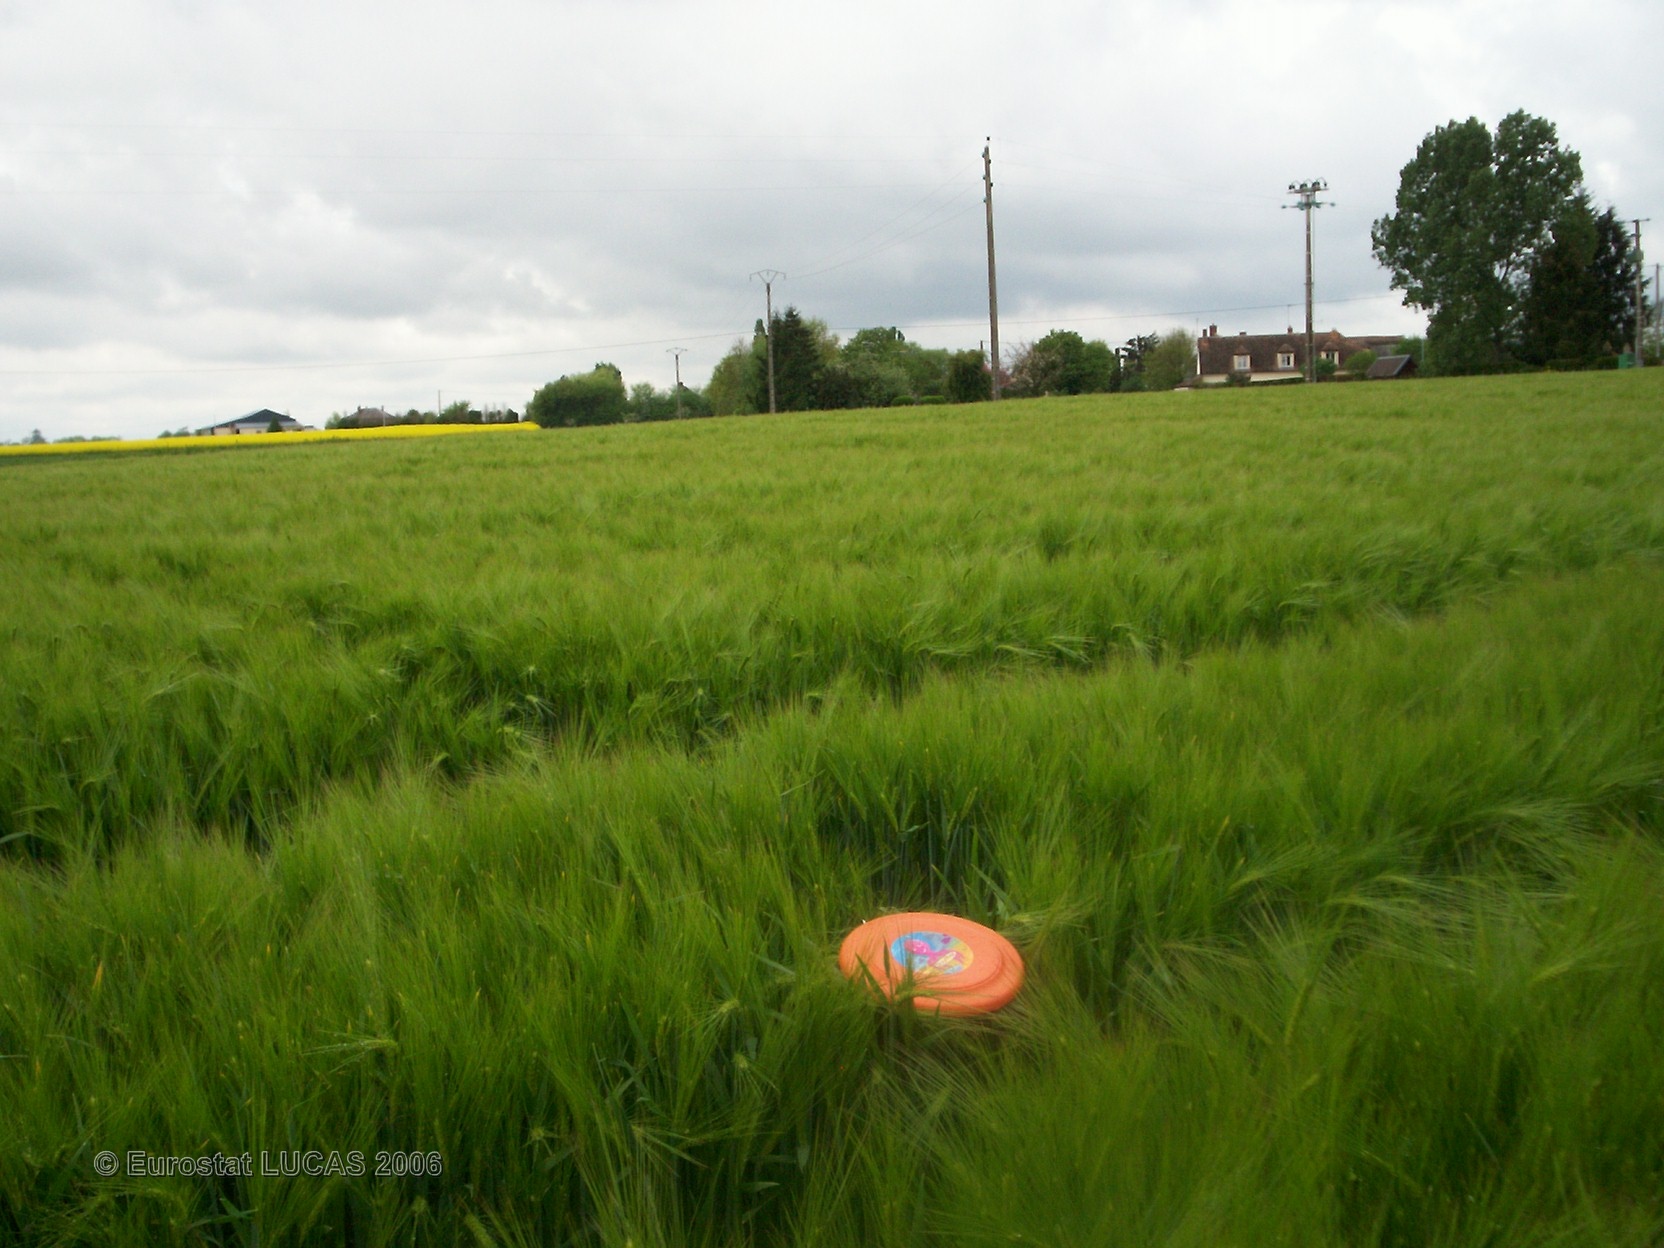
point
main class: Cropland
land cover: Barley
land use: Agriculture (excluding fallow land and kitchen gardens)
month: May
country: FR
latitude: 47.9785
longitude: 2.9324
